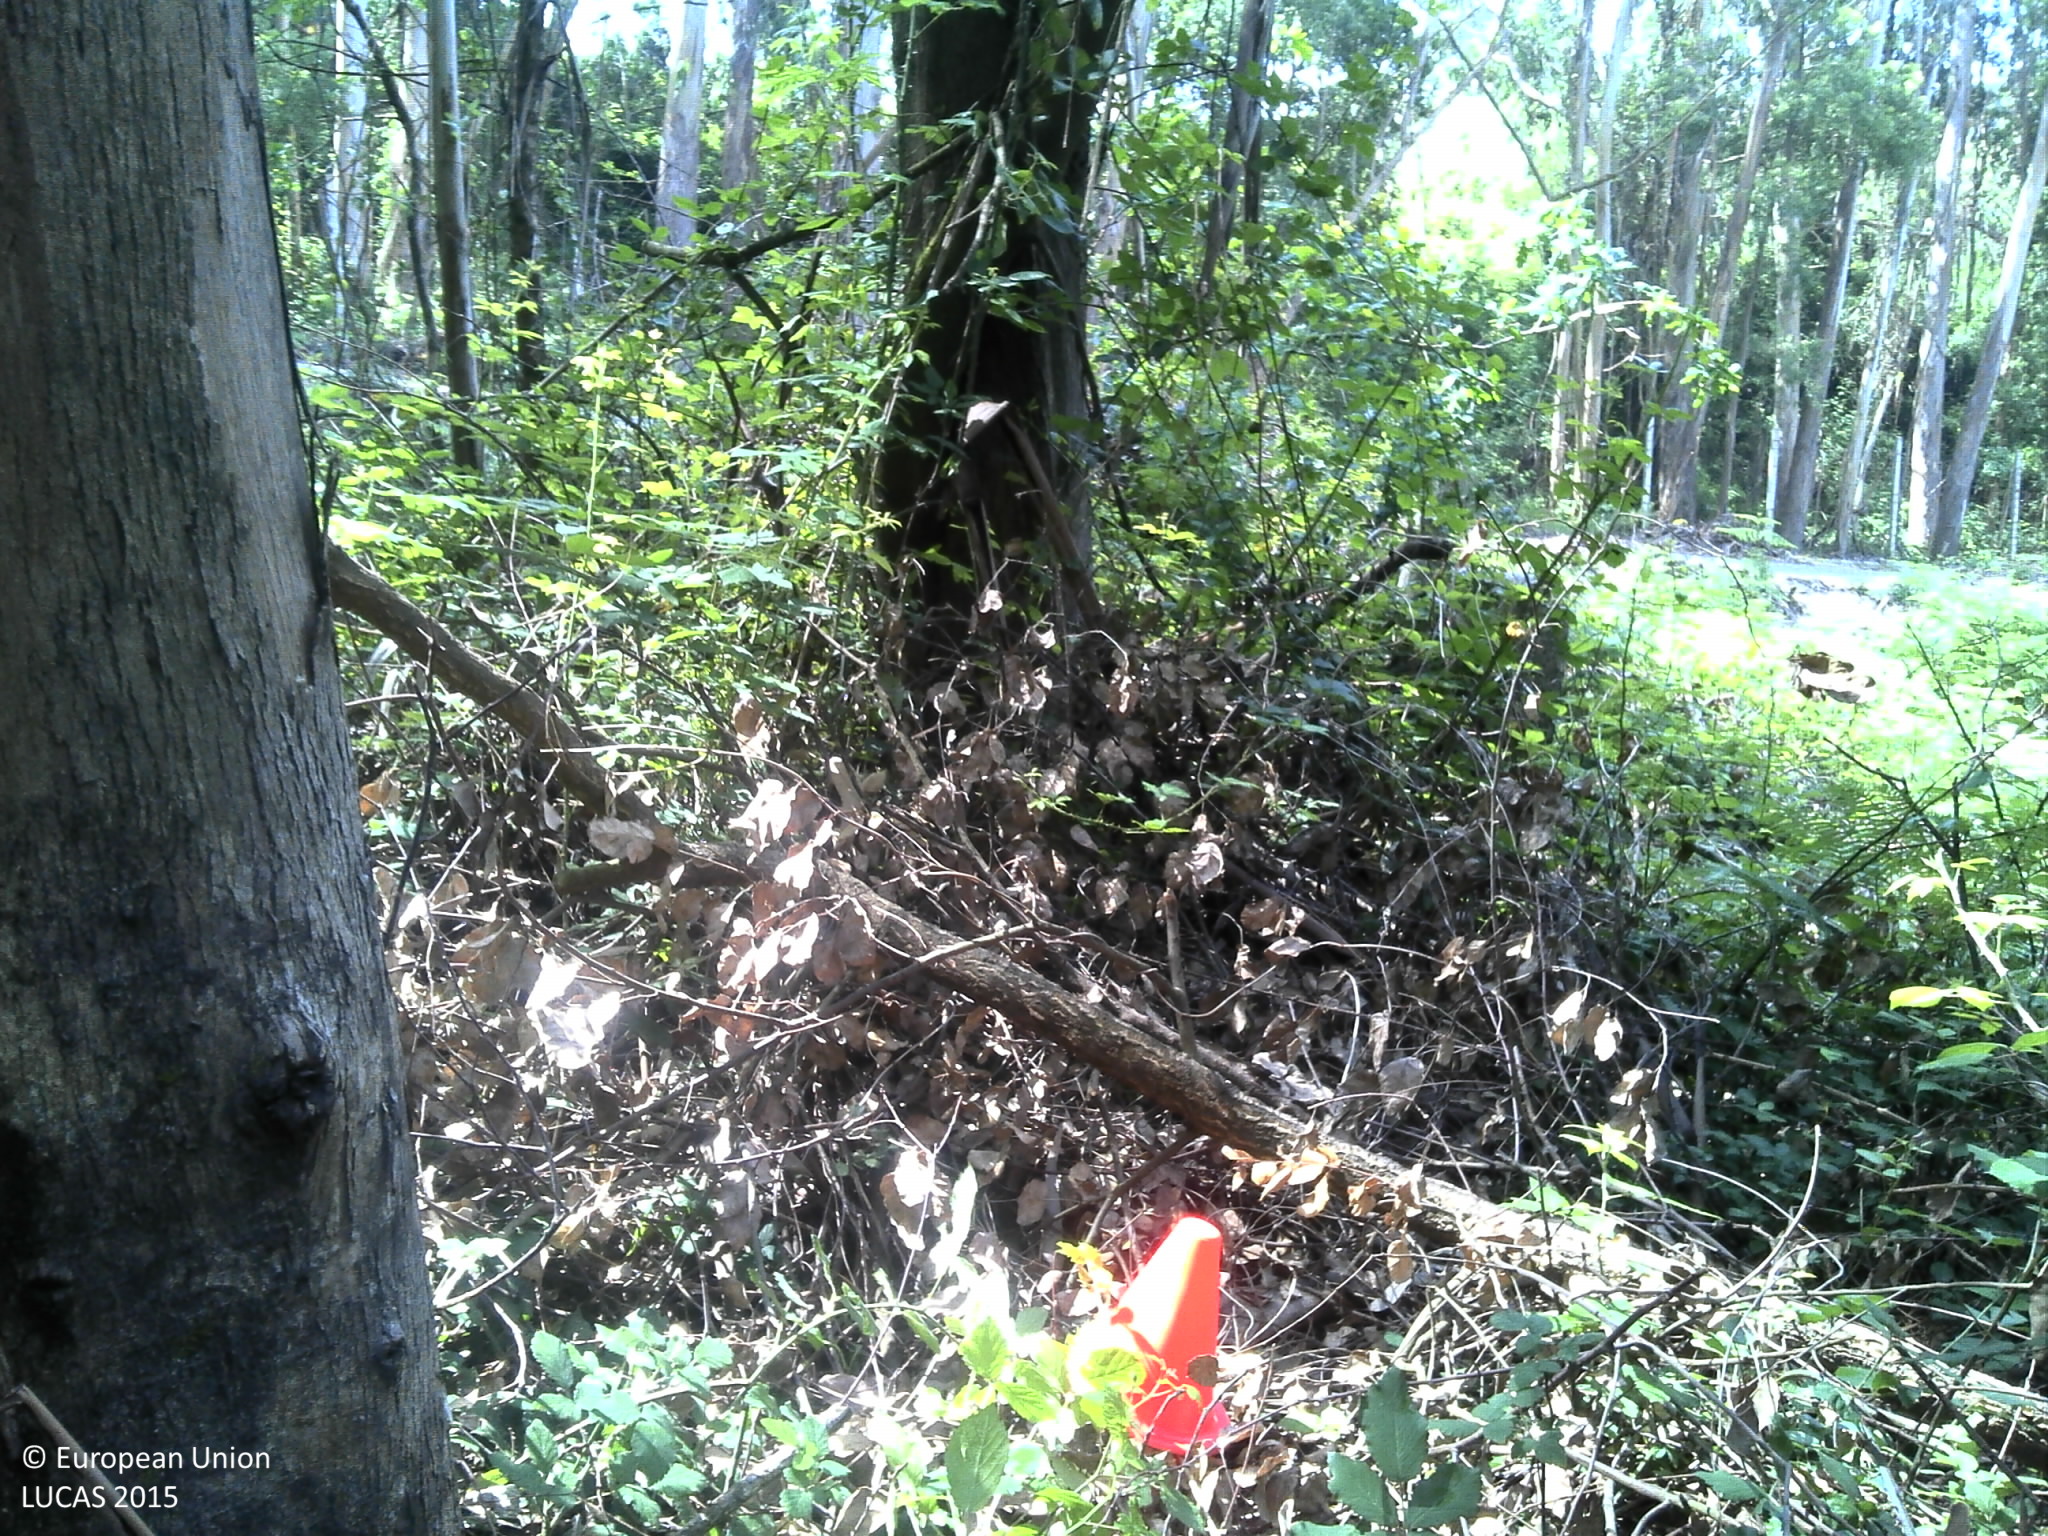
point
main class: Woodland
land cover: Broadleaved woodland
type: exotic forest
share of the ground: > 75 %
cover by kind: broadleaved forest trees 85 %, shrubs 10 %, unconsolidated bare surface 5 %
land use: Forestry
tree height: > 5 m
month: May
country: PT
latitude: 41.0816
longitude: -8.5888
